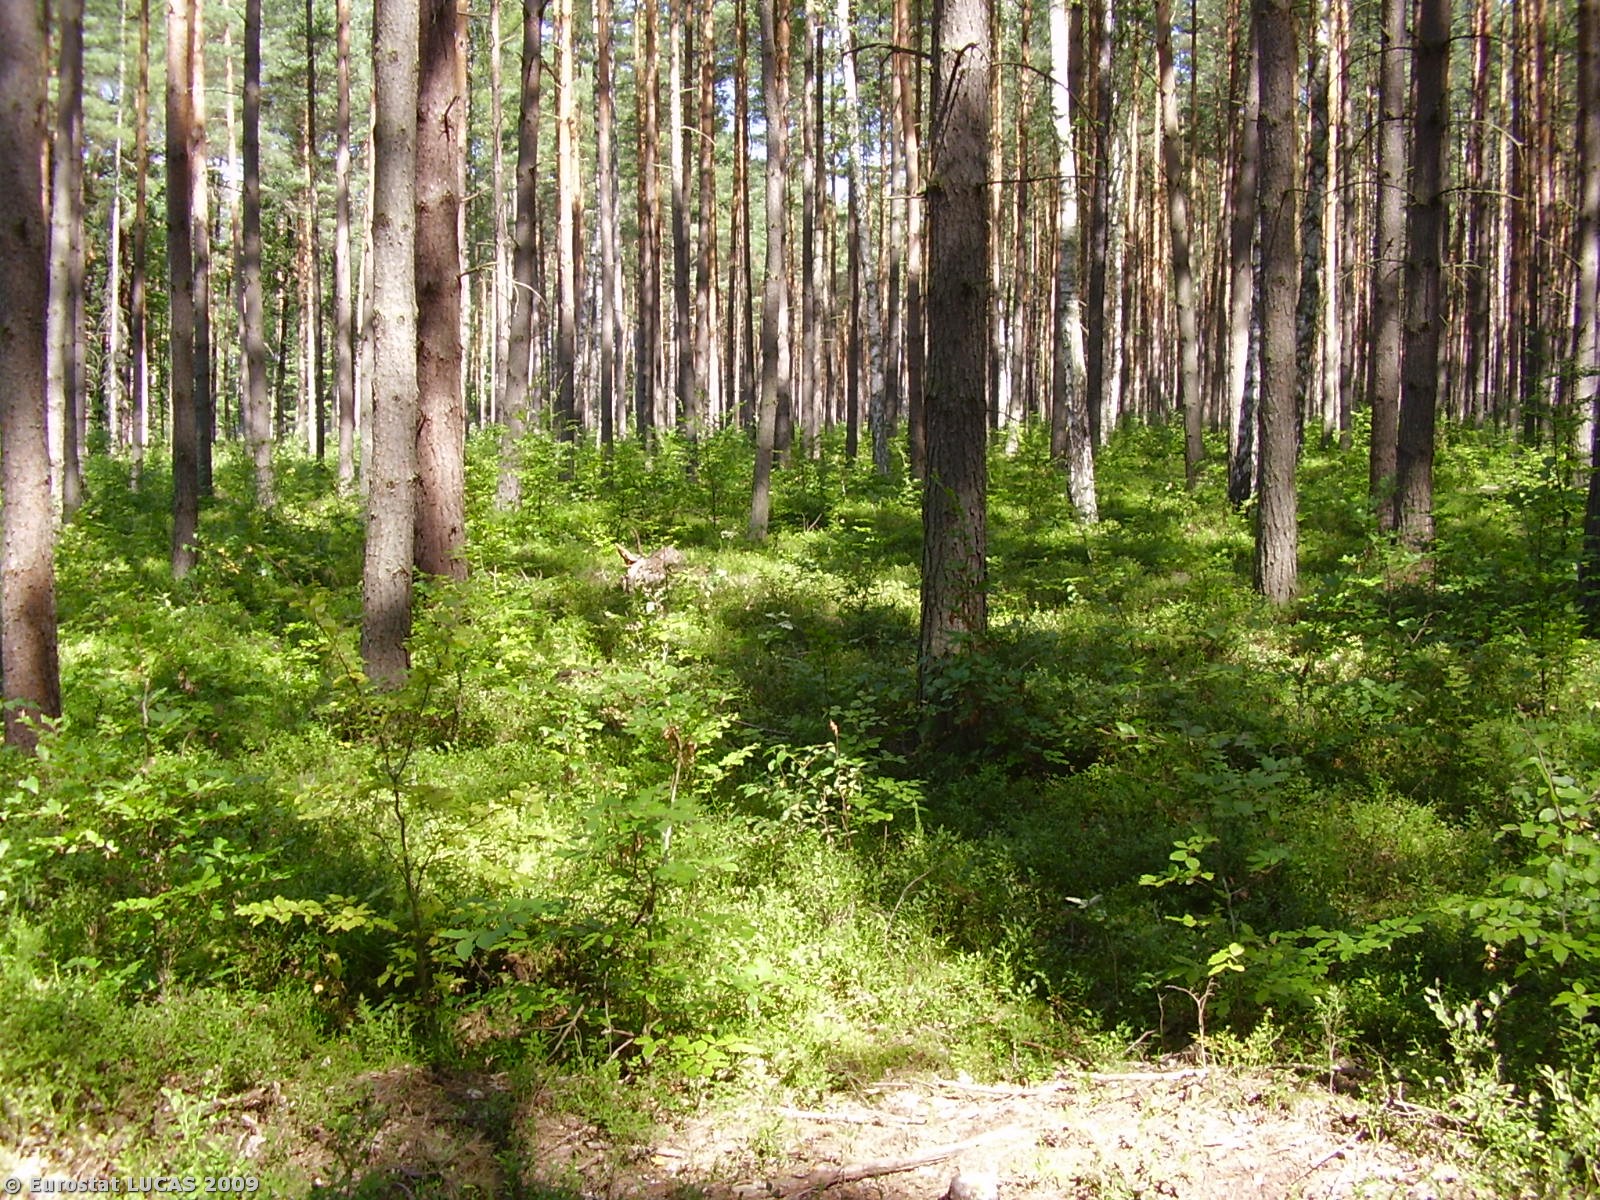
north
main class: Woodland
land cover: Mixed woodland
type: hemiboreal forest and nemoral coniferous forest and mixed broadleaved-coniferous forest
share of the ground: > 75 %
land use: Forestry
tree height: > 5 m
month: August
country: PL
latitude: 51.3749
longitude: 17.3242
